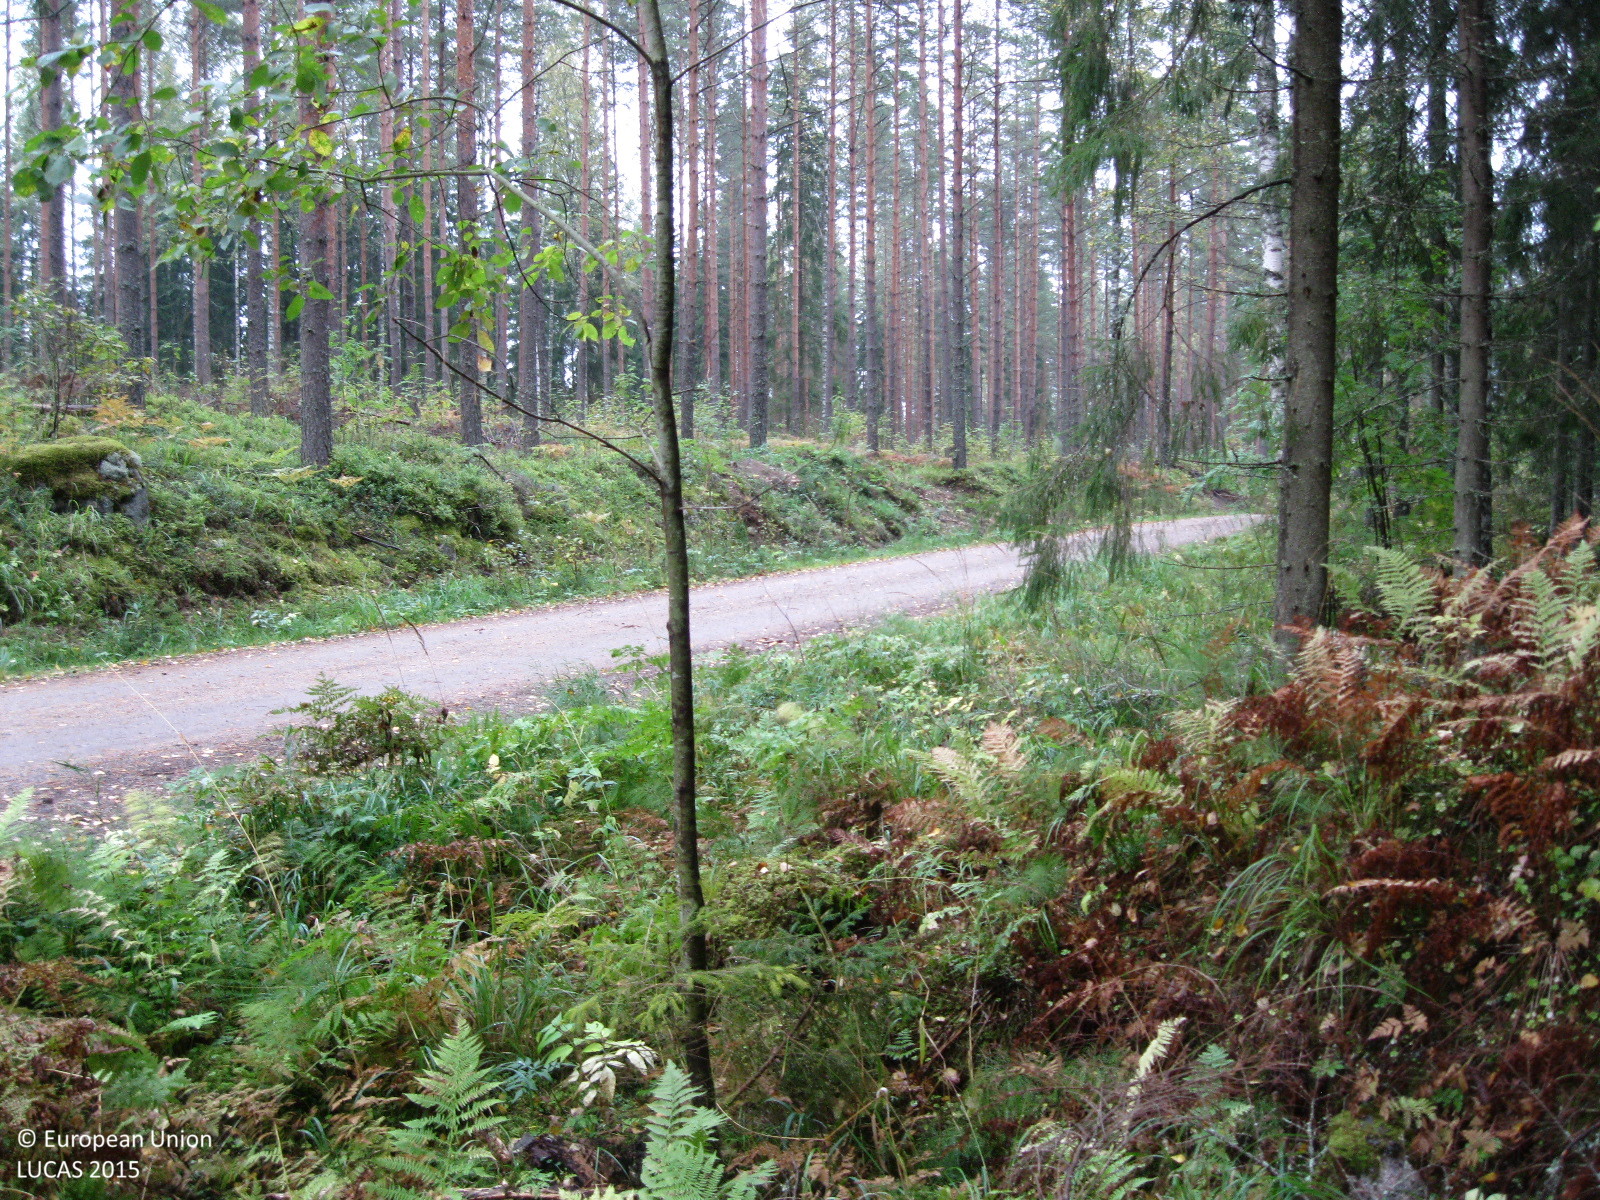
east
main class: Grassland
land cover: Spontaneously vegetated surfaces
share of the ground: > 75 %
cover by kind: herbaceous plants 100 %
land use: Forestry
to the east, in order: Spontaneously vegetated surfaces; Paved roads, cycling and walking lanes; Grass margins; Pine dominated mixed woodland; Spruce dominated mixed woodland; Ditches and canals; Broadleaved woodland
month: September
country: FI
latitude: 60.9063
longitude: 24.9170
